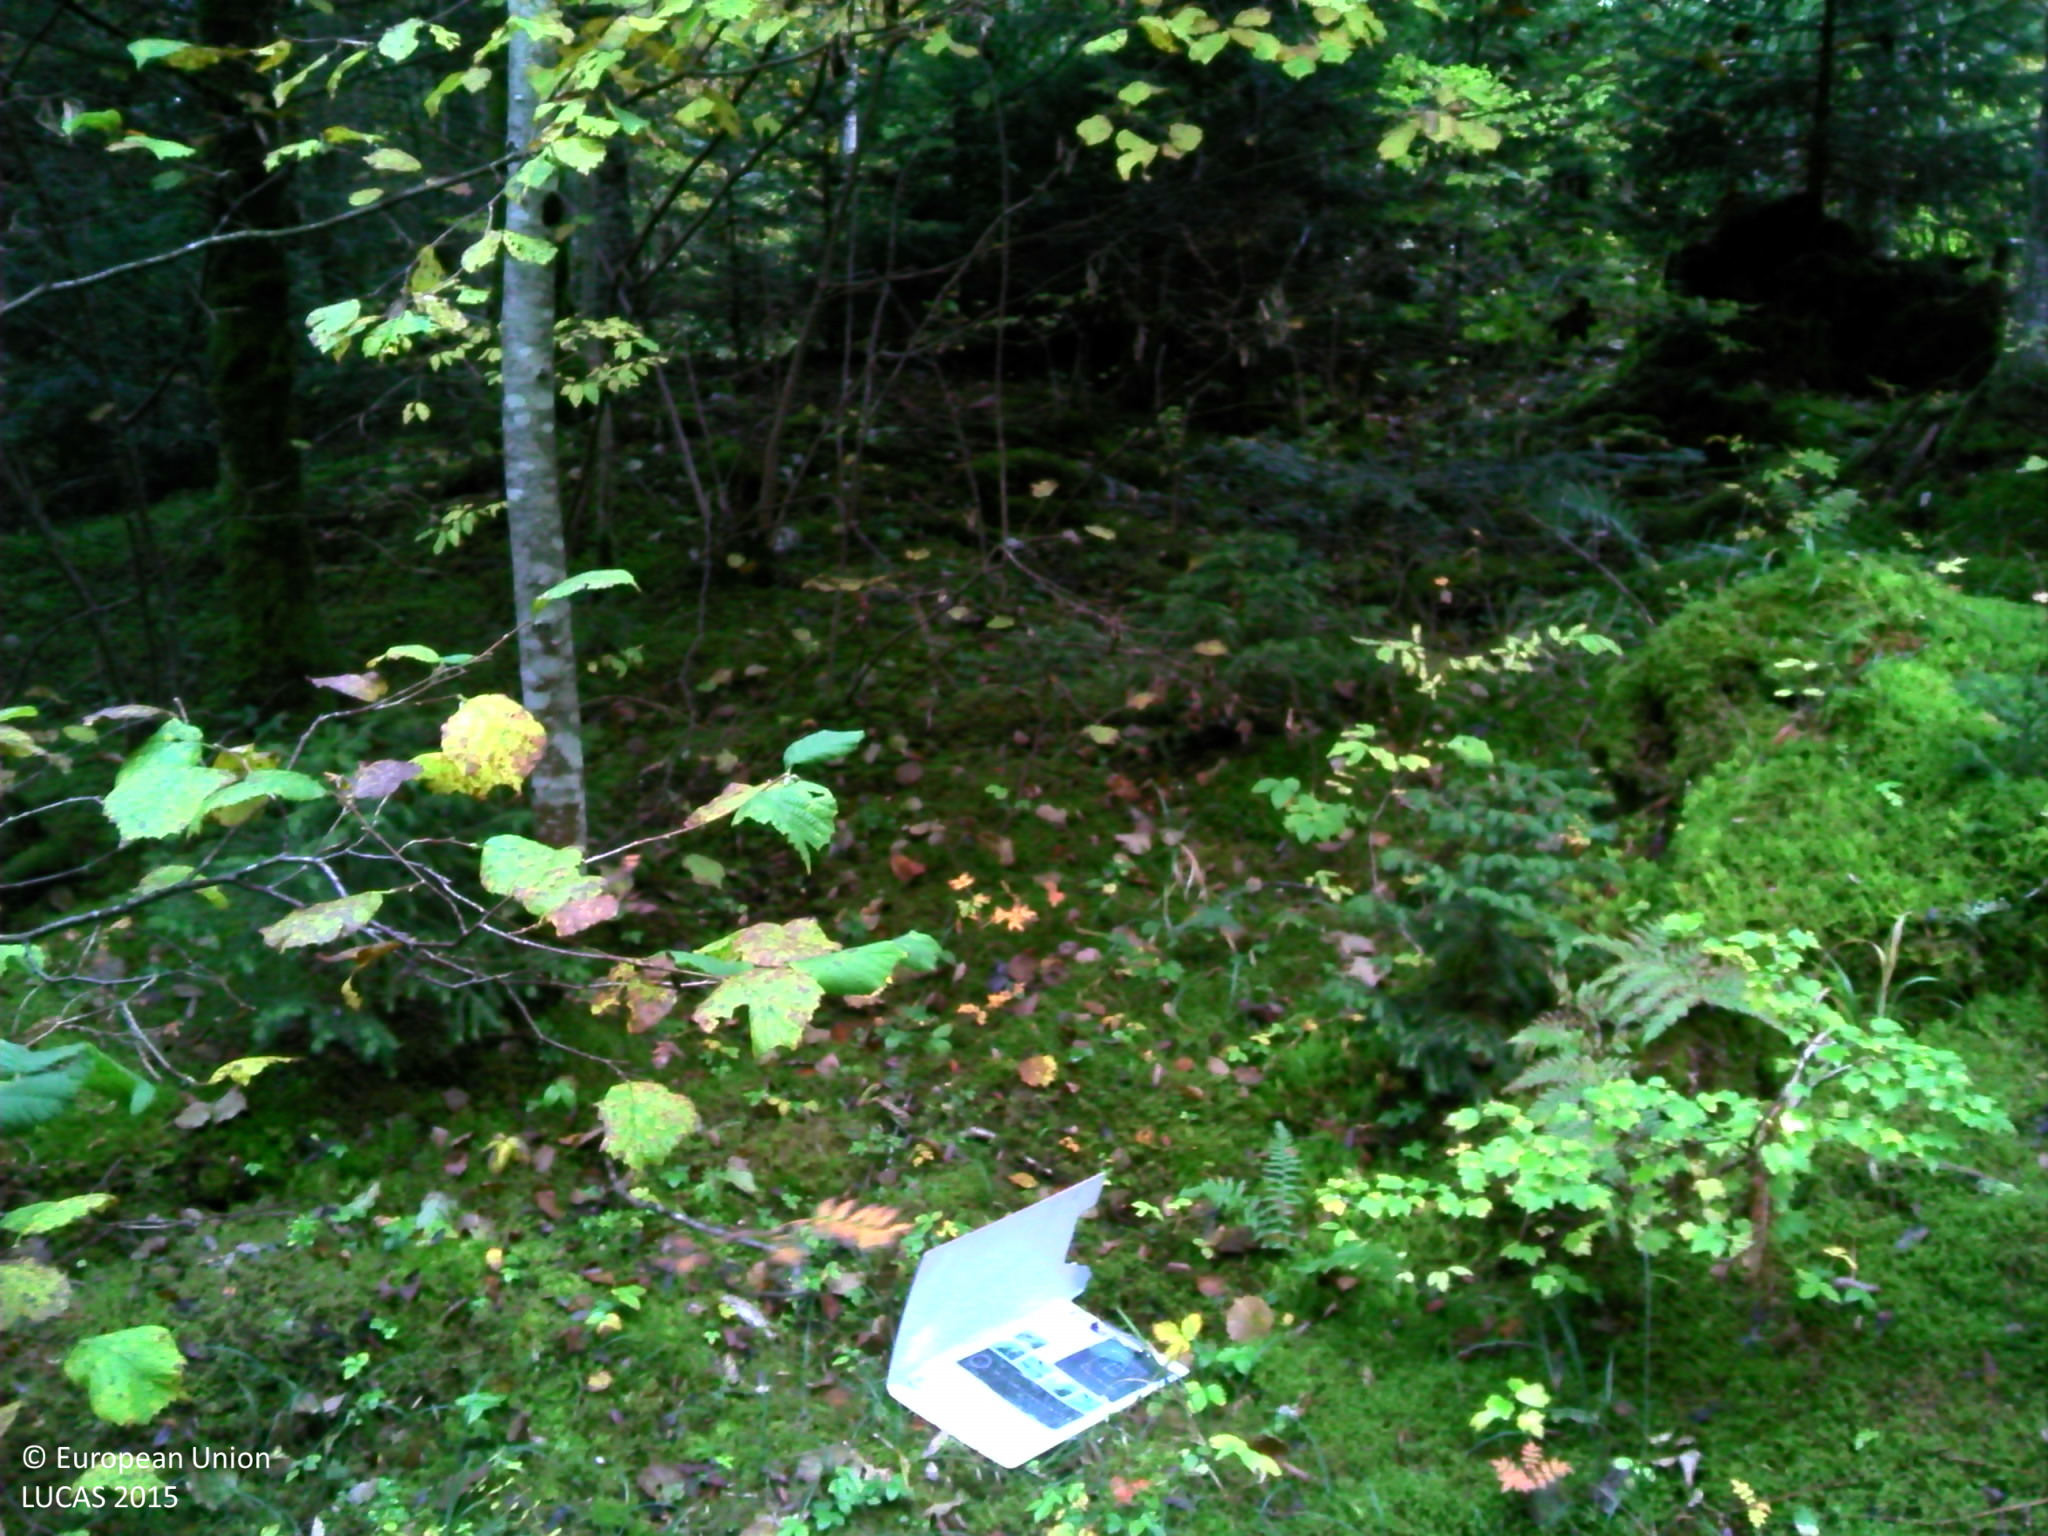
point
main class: Woodland
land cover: Spruce dominated mixed woodland
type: hemiboreal forest and nemoral coniferous forest and mixed broadleaved-coniferous forest
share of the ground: > 75 %
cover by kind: coniferous forest trees 40 %, broadleaved forest trees 40 %, shrubs 20 %
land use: Forestry
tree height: > 5 m
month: October
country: FR
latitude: 46.7927
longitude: 6.3213
